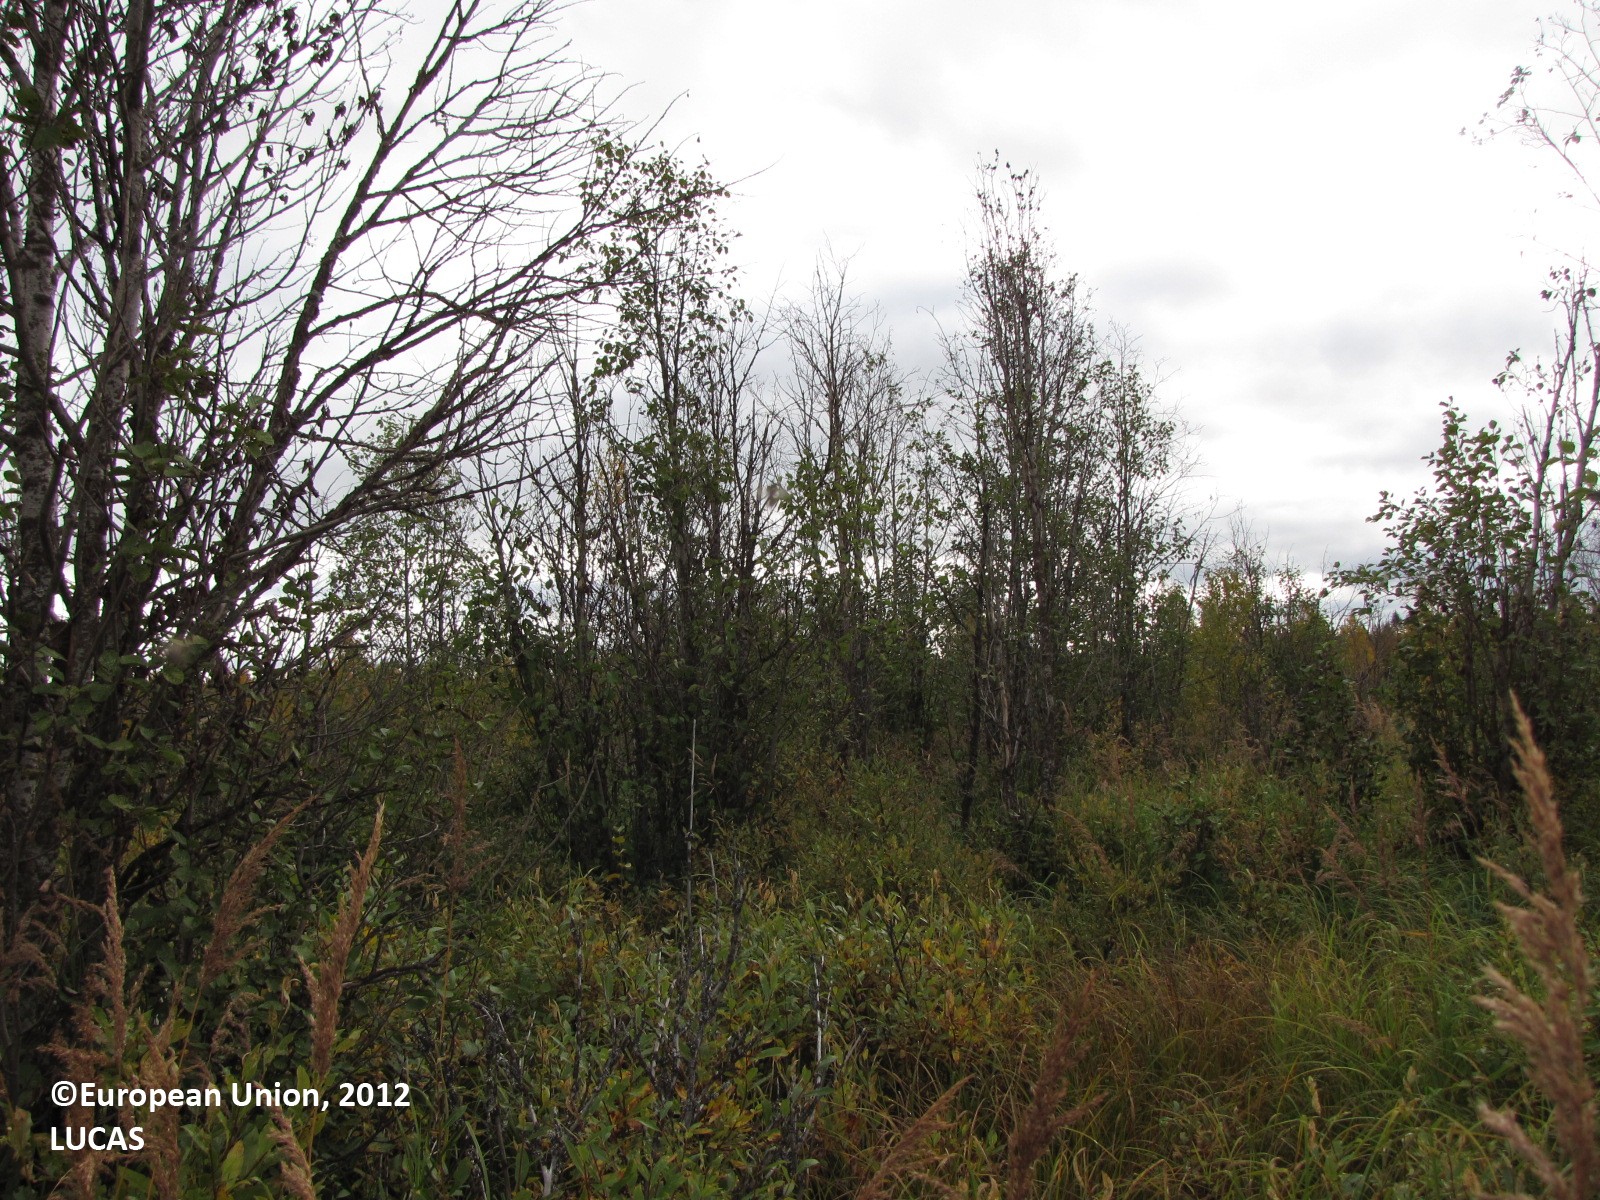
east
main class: Woodland
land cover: Broadleaved woodland
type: boreal forest
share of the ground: 10 - 25 %
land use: Forestry
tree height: > 5 m
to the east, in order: Broadleaved woodland; Grassland with sparse tree/shrub cover; Broadleaved woodland; Grassland with sparse tree/shrub cover; Ditches and canals; Spontaneously vegetated surfaces
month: September
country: FI
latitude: 67.1983
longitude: 23.5945
